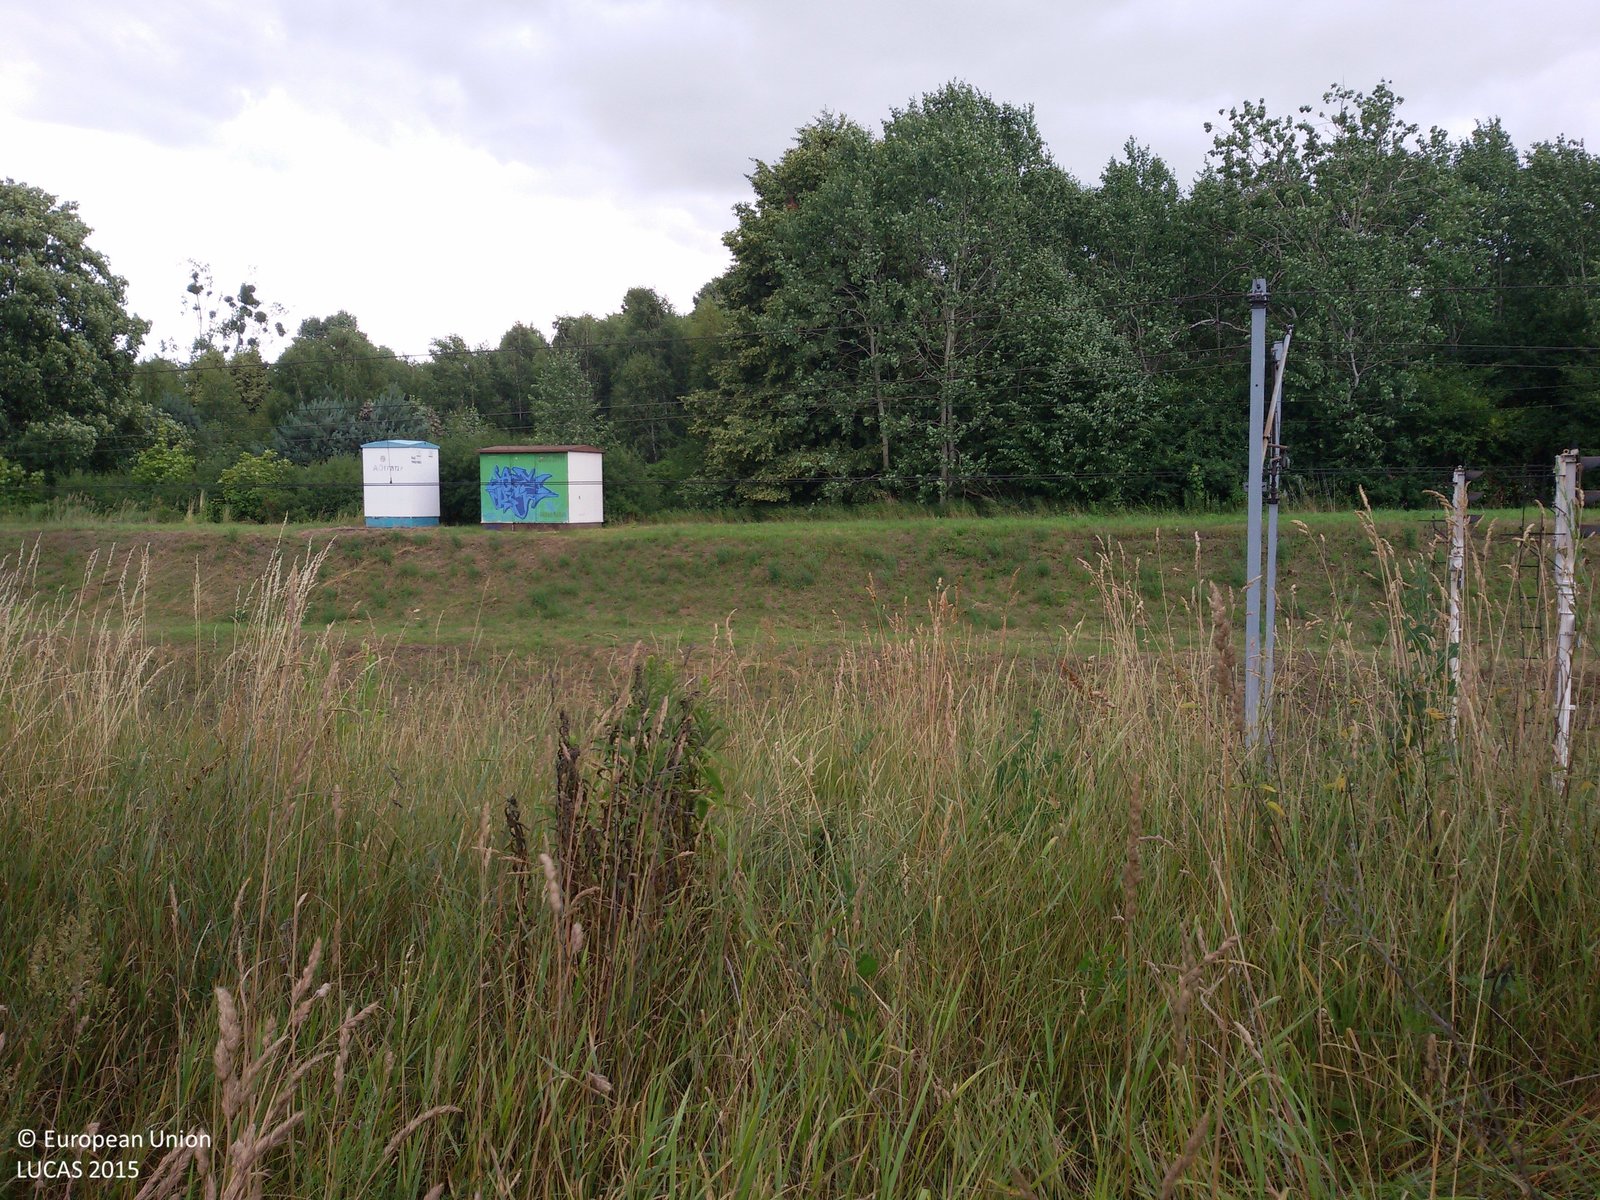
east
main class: Shrubland
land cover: Shrubland with sparse tree cover
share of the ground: > 75 %
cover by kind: shrubs 85 %, herbaceous plants 10 %, broadleaved forest trees 5 %
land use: Abandoned areas
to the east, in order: Shrubland with sparse tree cover; Spontaneously vegetated surfaces; Railways; Electric lines; Railways; Grassland without tree/shrub cover; Broadleaved woodland; Paved roads, cycling and walking lanes; Fences; Broadleaved woodland
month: July
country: PL
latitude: 51.7861
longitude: 19.8455
